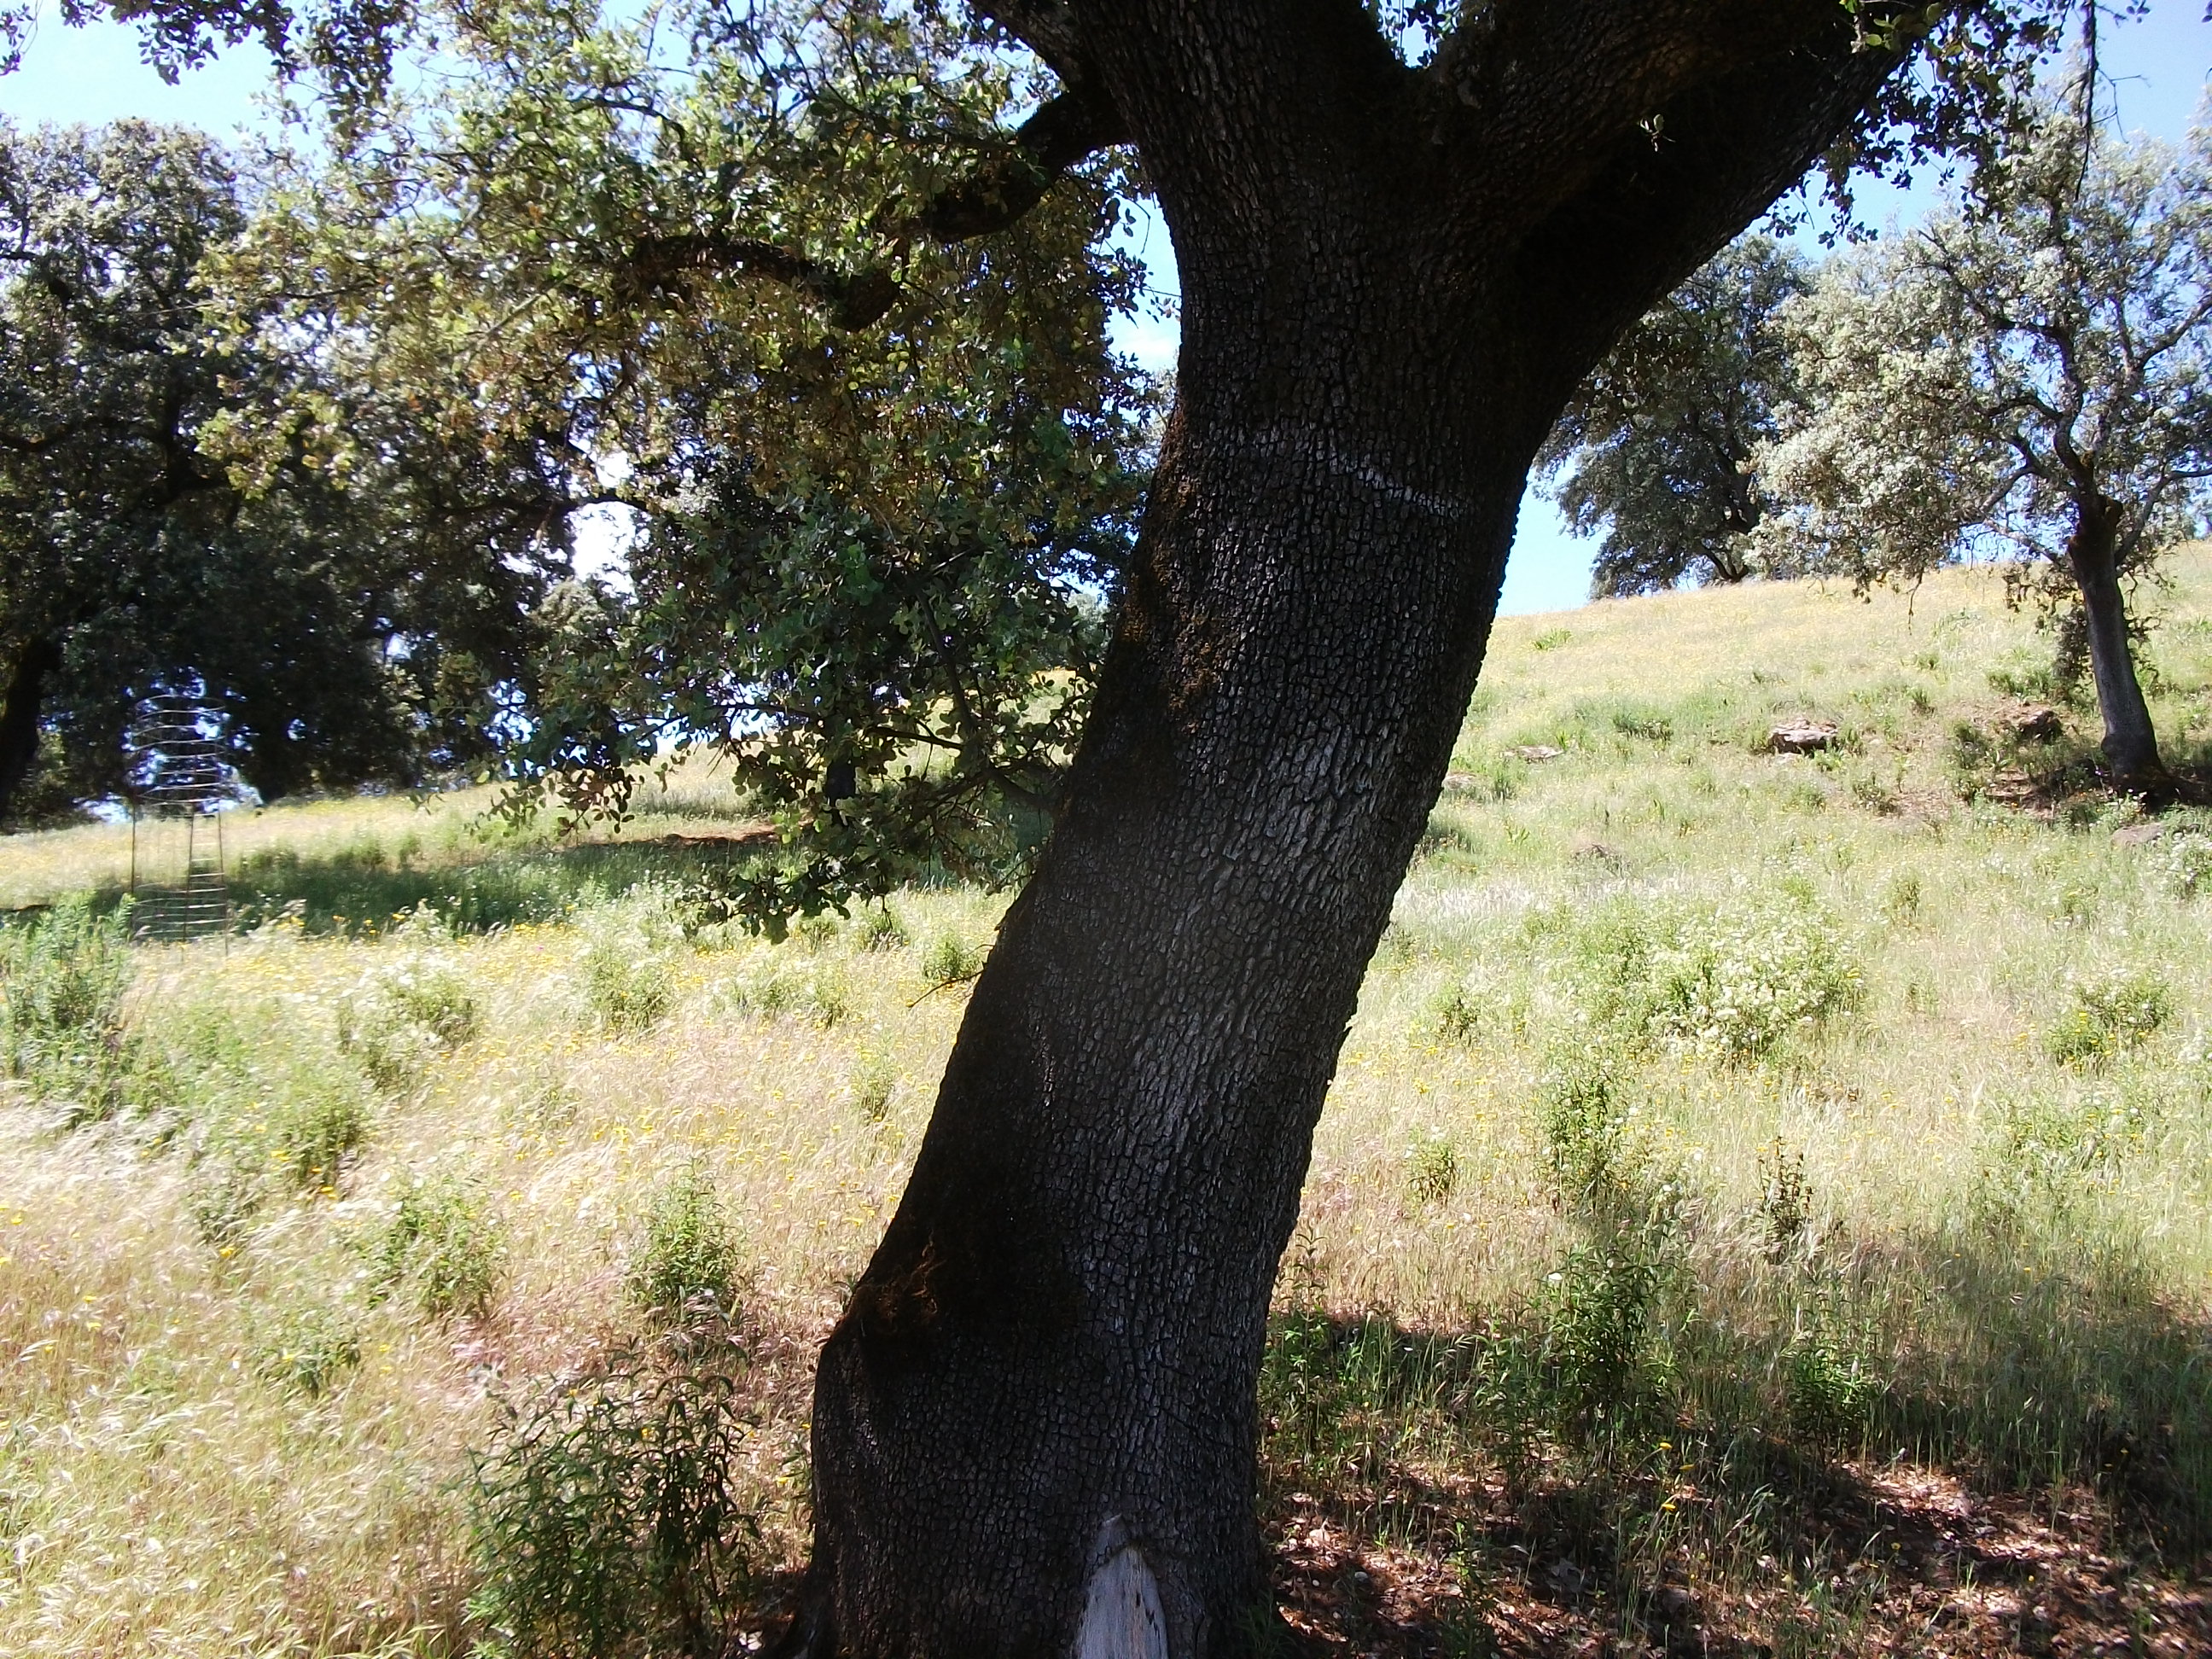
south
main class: Woodland
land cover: Broadleaved woodland
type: broadleaved evergreen forest
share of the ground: 25 - 50 %
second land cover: Grassland without tree/shrub cover
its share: > 75 %
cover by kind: broadleaved forest trees 50 %, herbaceous plants 50 %
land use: Forestry
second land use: Agriculture (excluding fallow land and kitchen gardens)
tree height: > 5 m
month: May
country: ES
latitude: 37.9297
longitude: -7.0627
